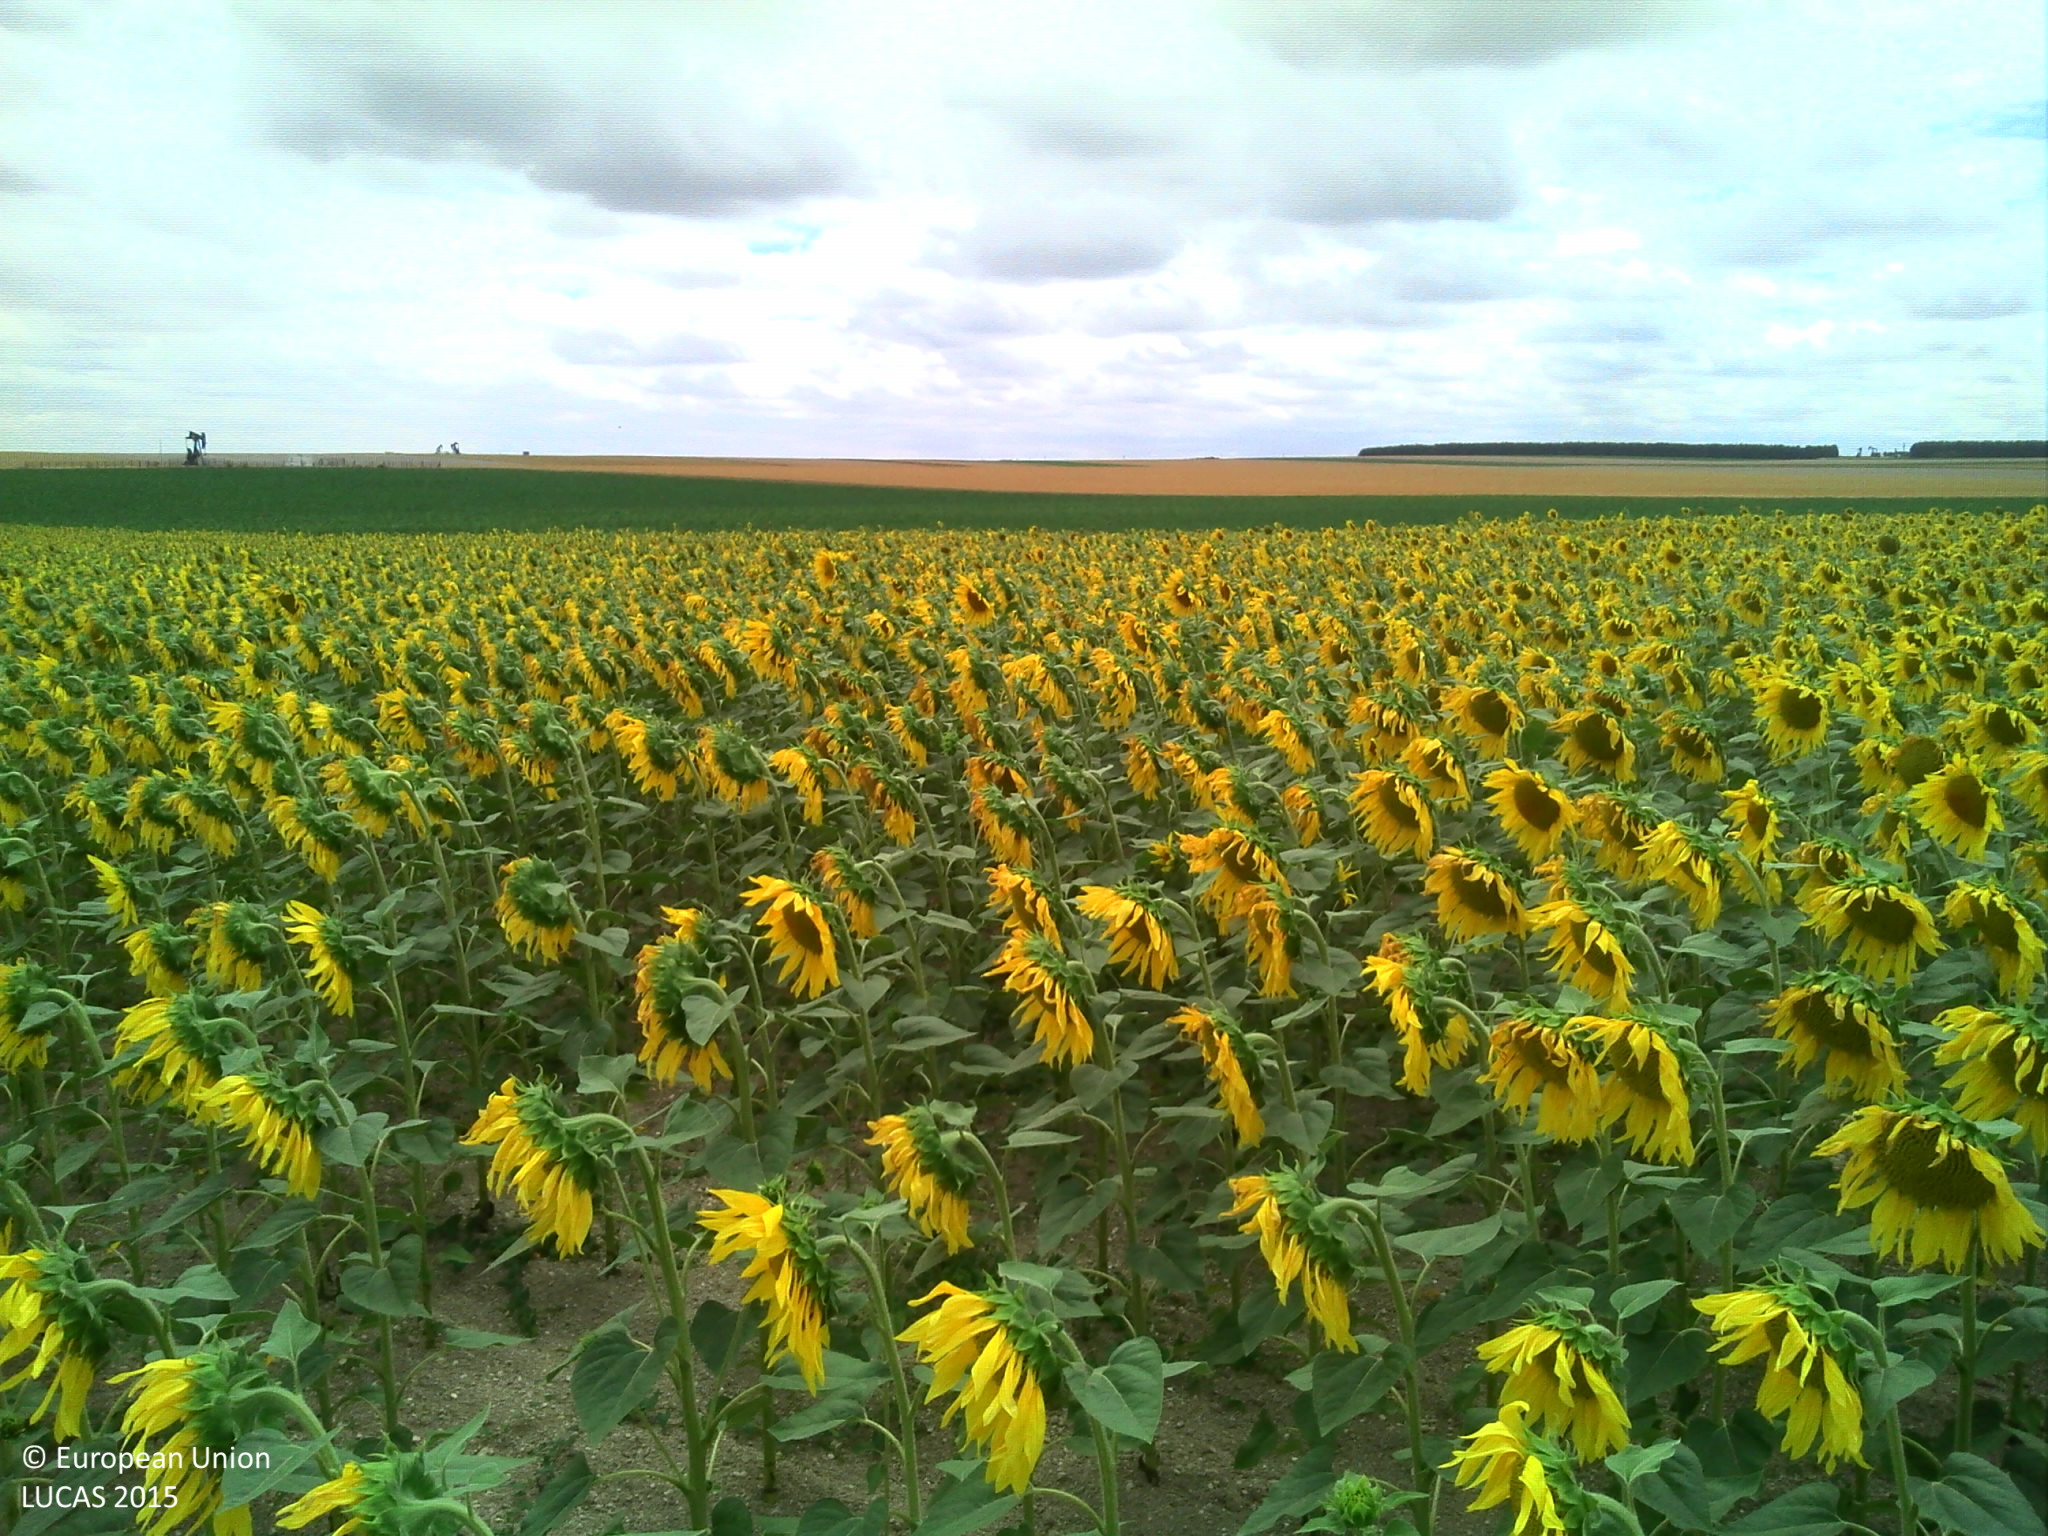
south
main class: Cropland
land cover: Sunflower
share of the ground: > 75 %
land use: Agriculture (excluding fallow land and kitchen gardens)
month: July
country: FR
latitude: 48.8274
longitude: 4.1794
